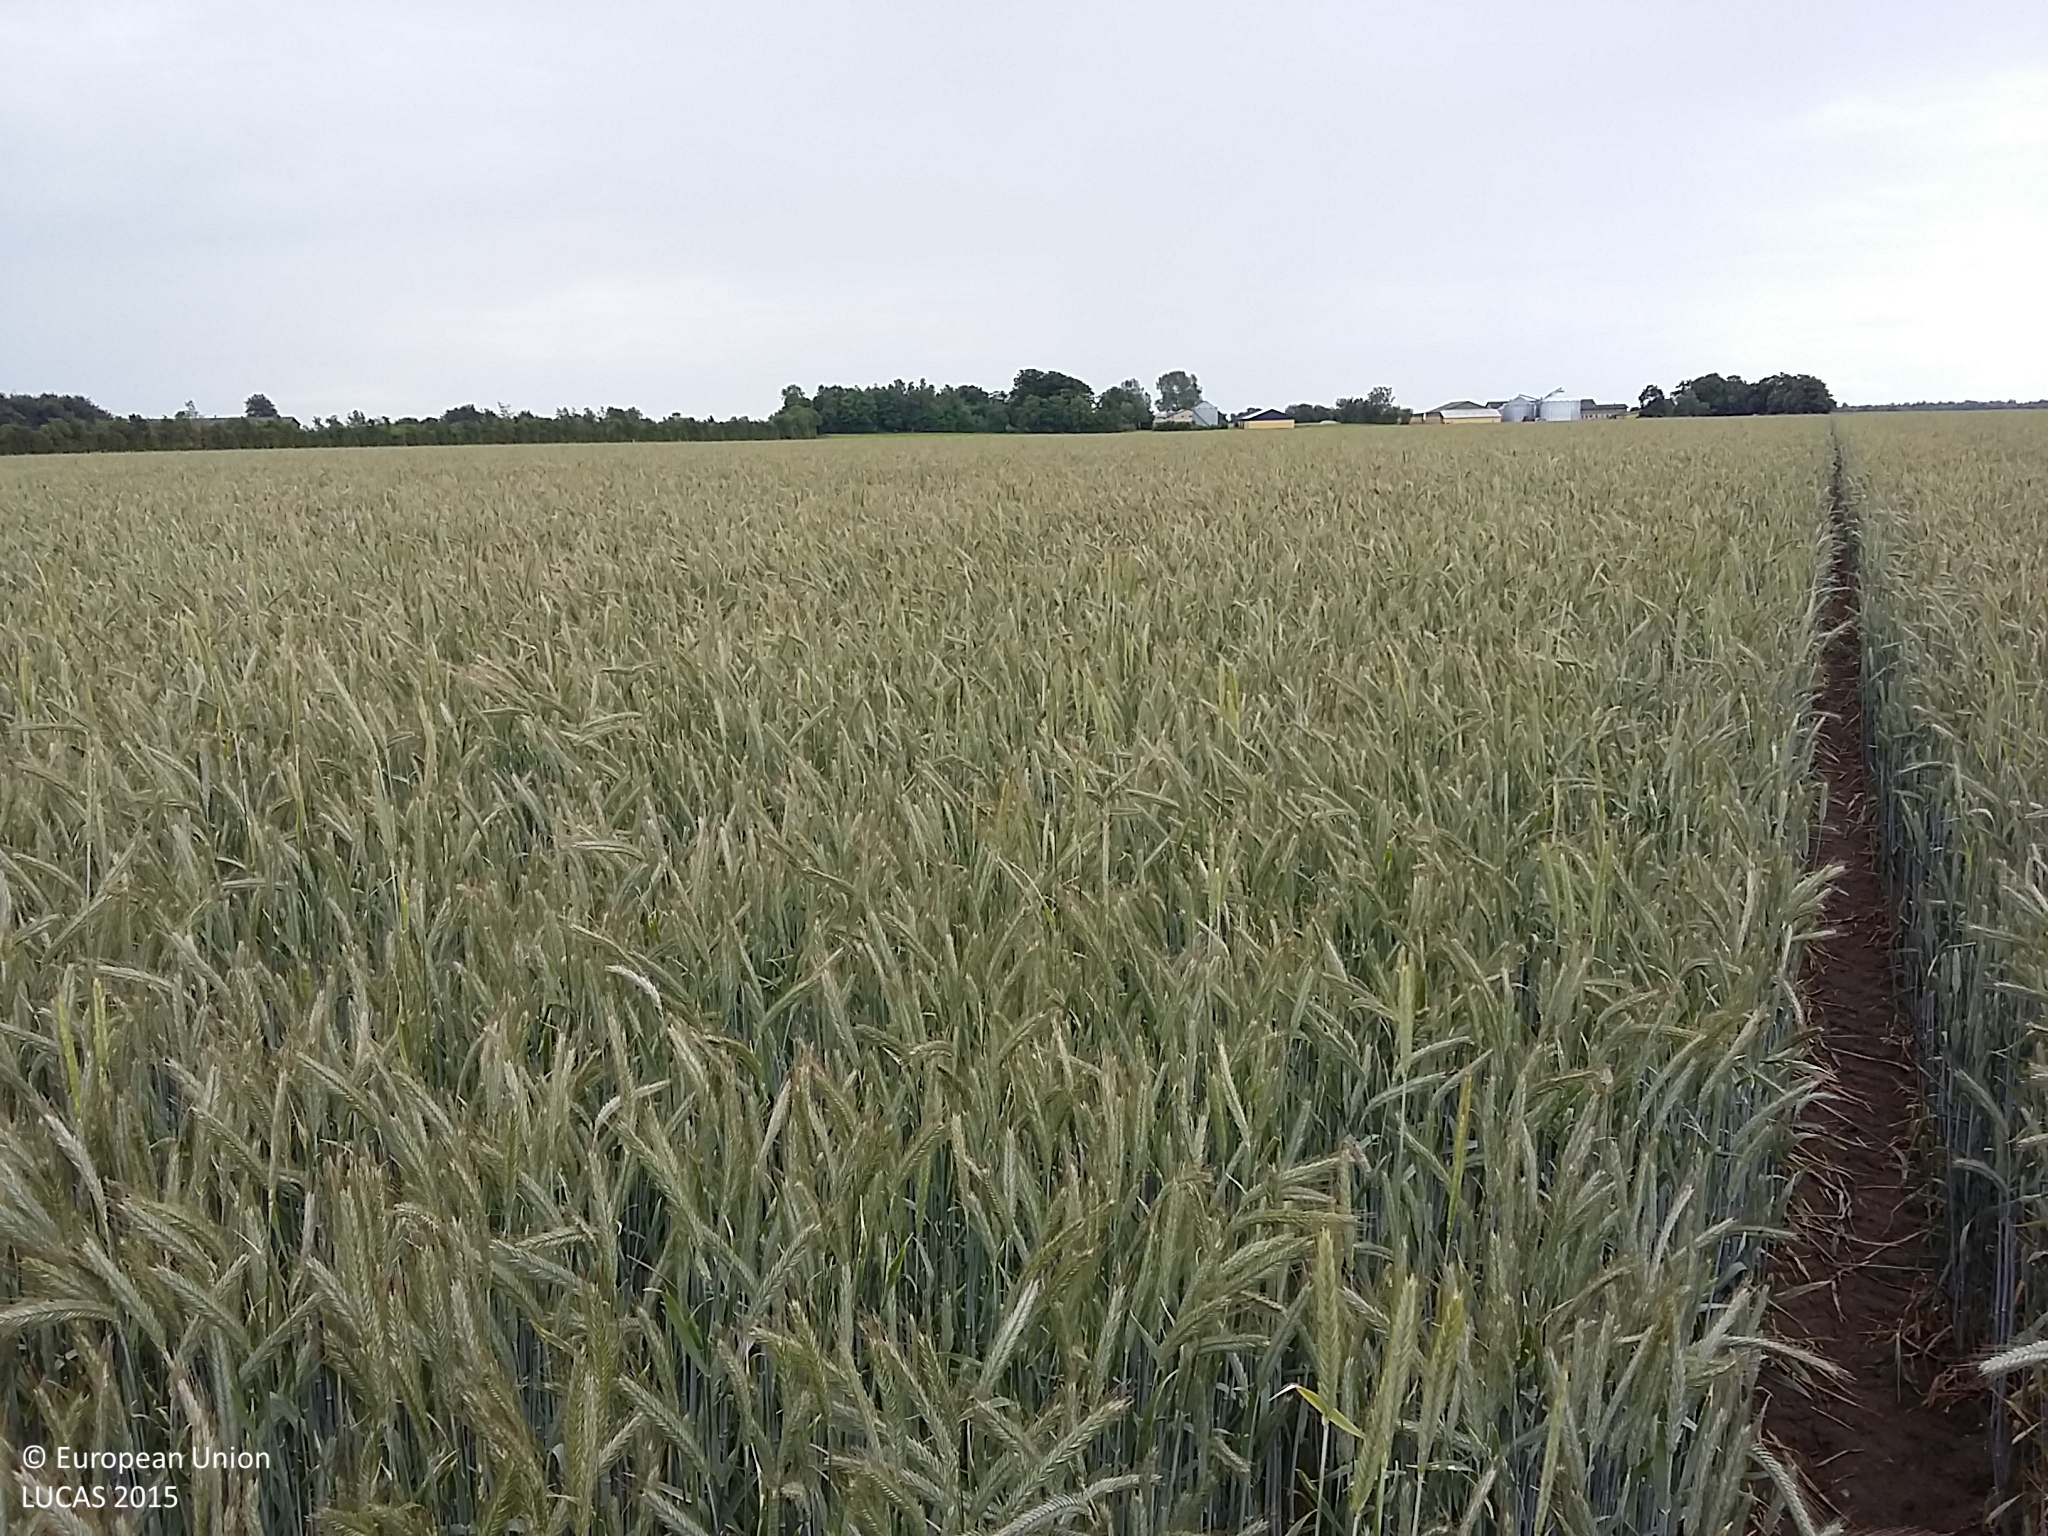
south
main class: Cropland
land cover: Rye
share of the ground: > 75 %
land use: Agriculture (excluding fallow land and kitchen gardens)
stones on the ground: < 10 %
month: June
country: DK
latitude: 54.7435
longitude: 11.2574
